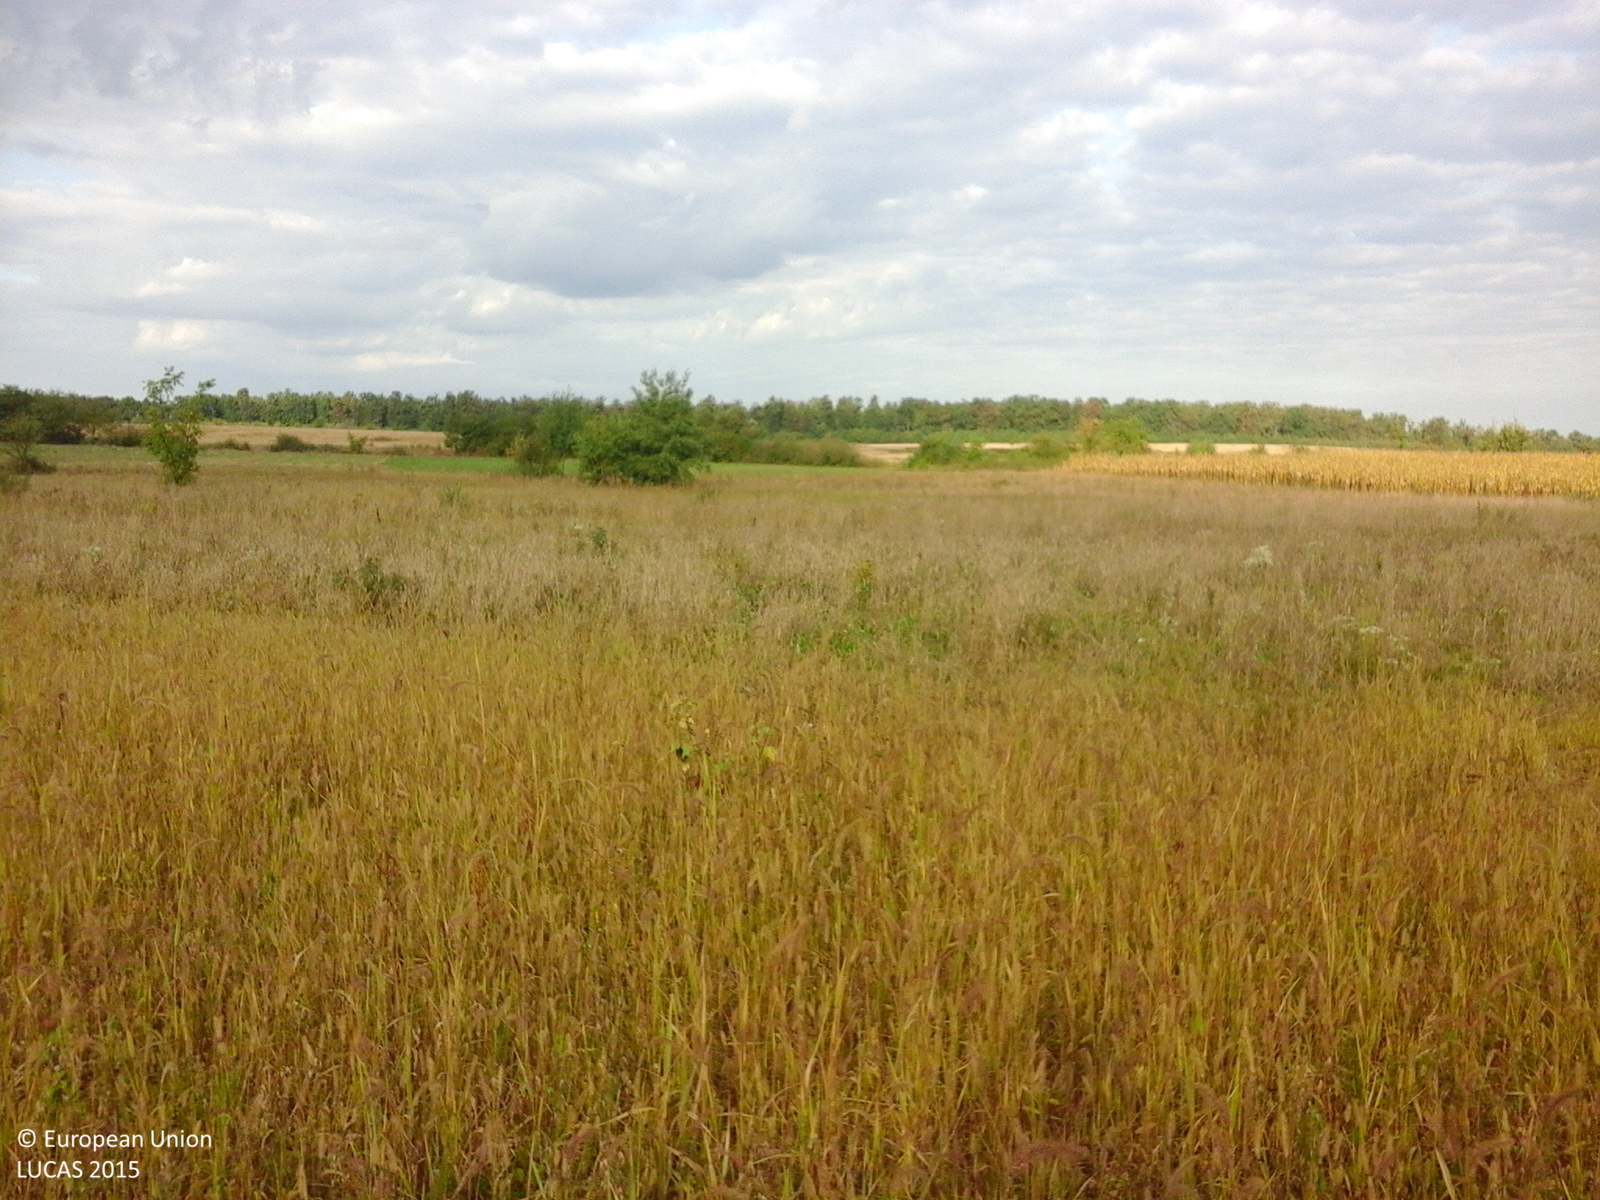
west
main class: Grassland
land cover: Grassland without tree/shrub cover
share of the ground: > 75 %
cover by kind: herbaceous plants 100 %
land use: Agriculture (excluding fallow land and kitchen gardens)
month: September
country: RO
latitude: 47.5934
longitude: 23.4656
